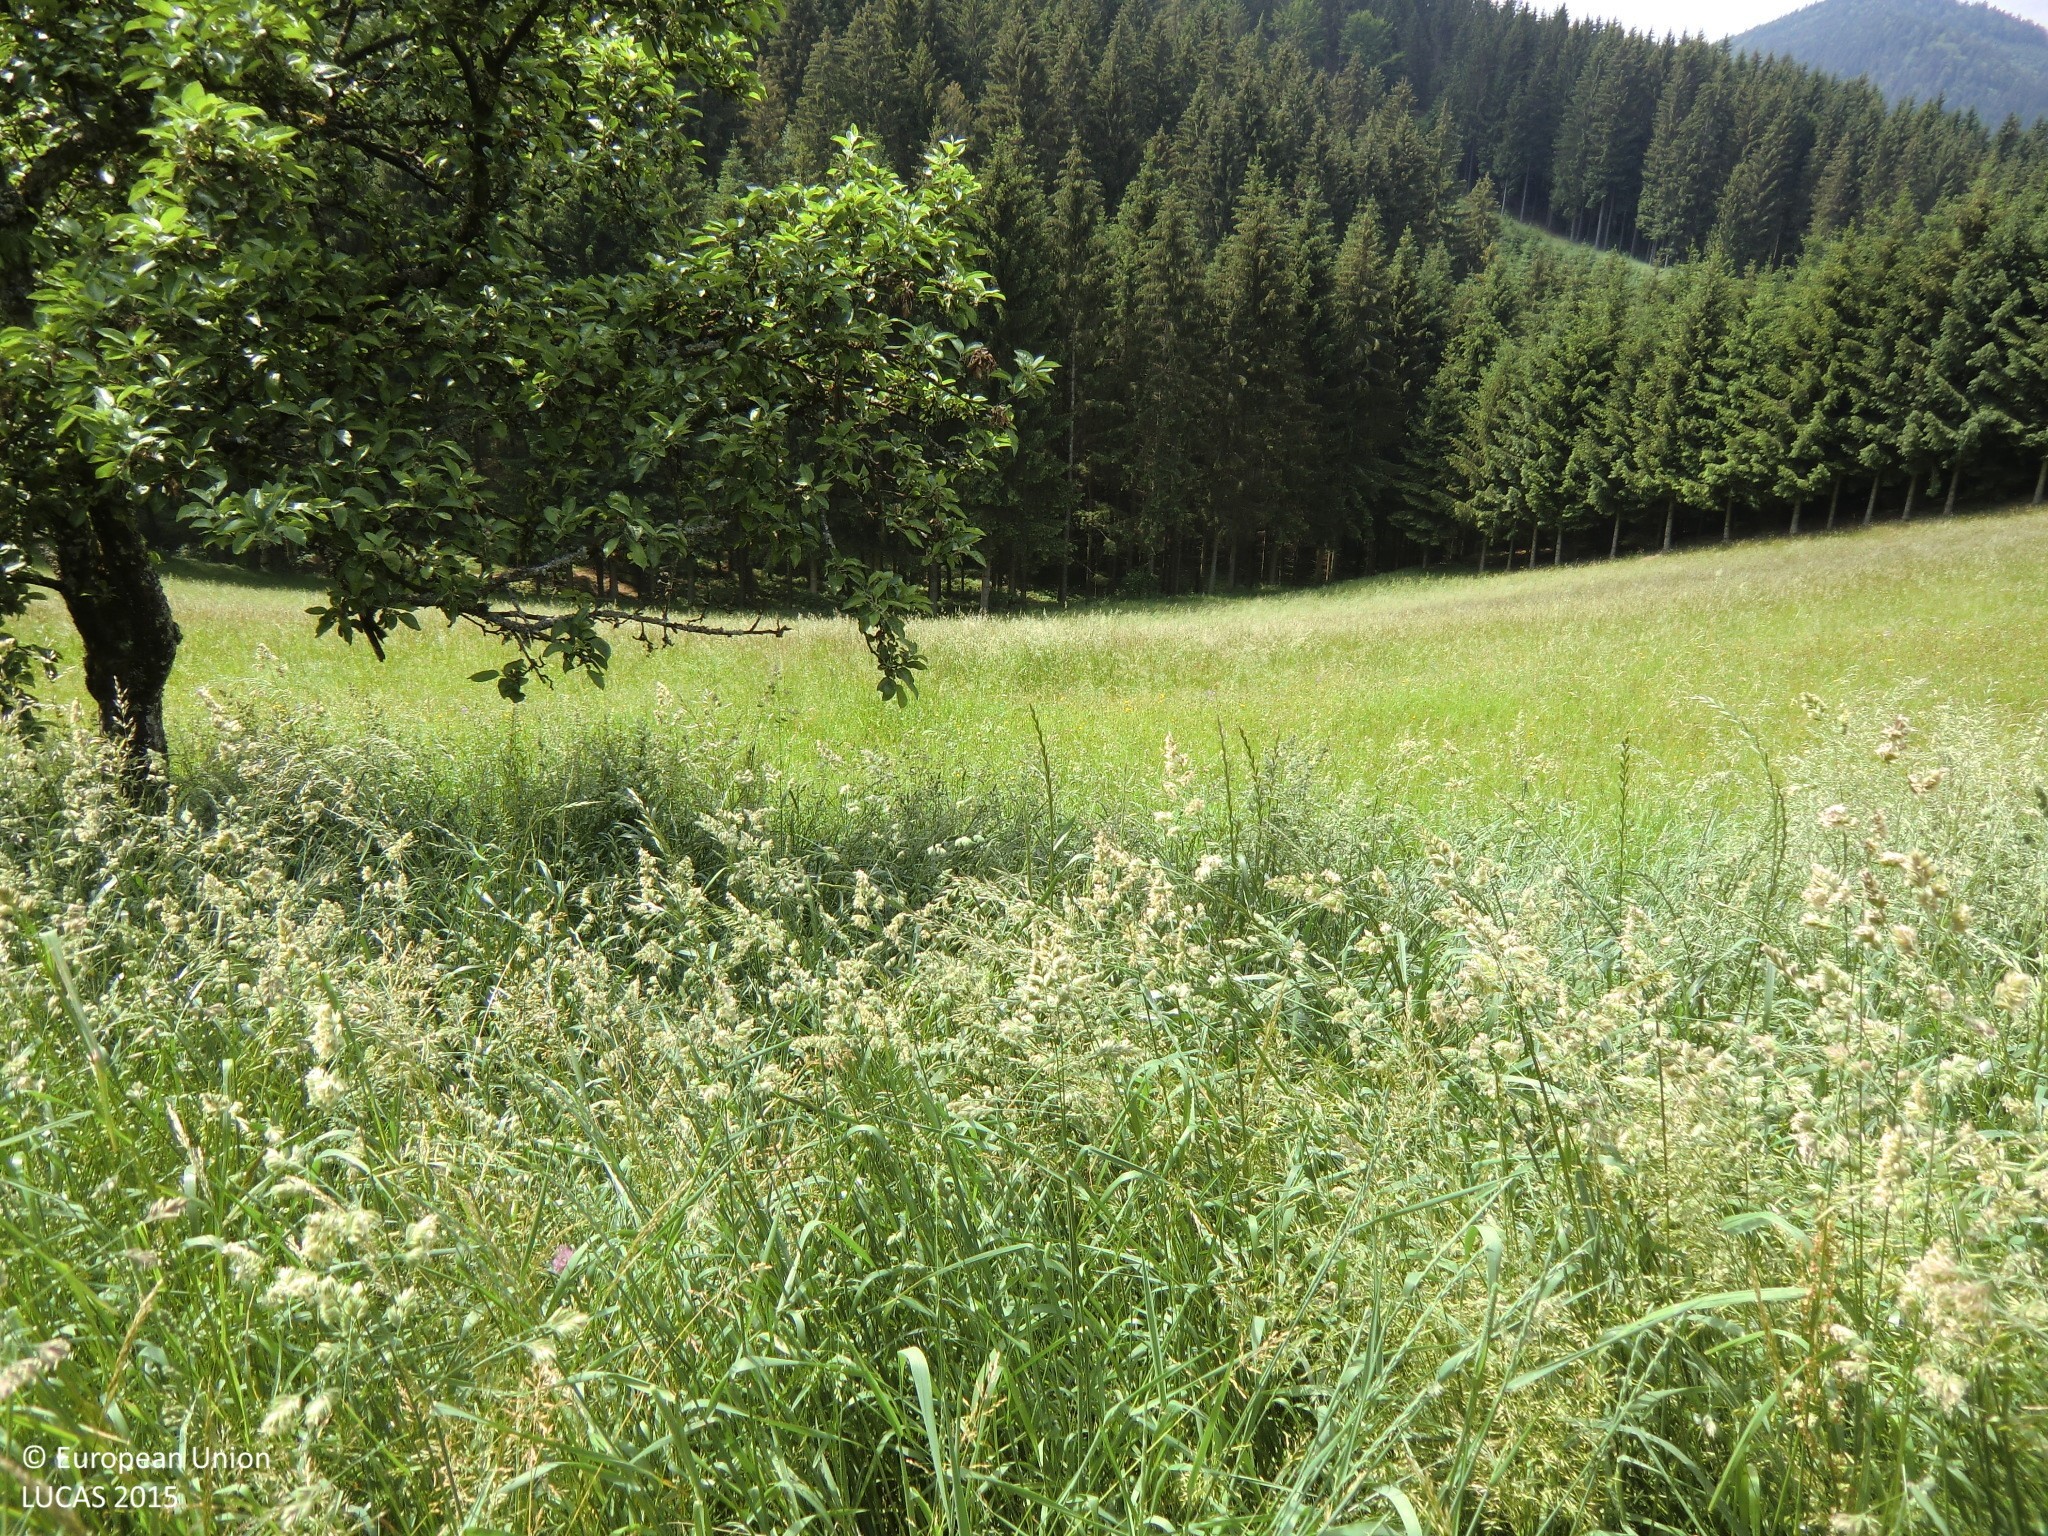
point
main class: Cropland
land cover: Apple fruit
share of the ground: 25 - 50 %
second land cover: Grassland without tree/shrub cover
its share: > 75 %
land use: Agriculture (excluding fallow land and kitchen gardens)
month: June
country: AT
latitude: 48.3717
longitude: 14.7934
